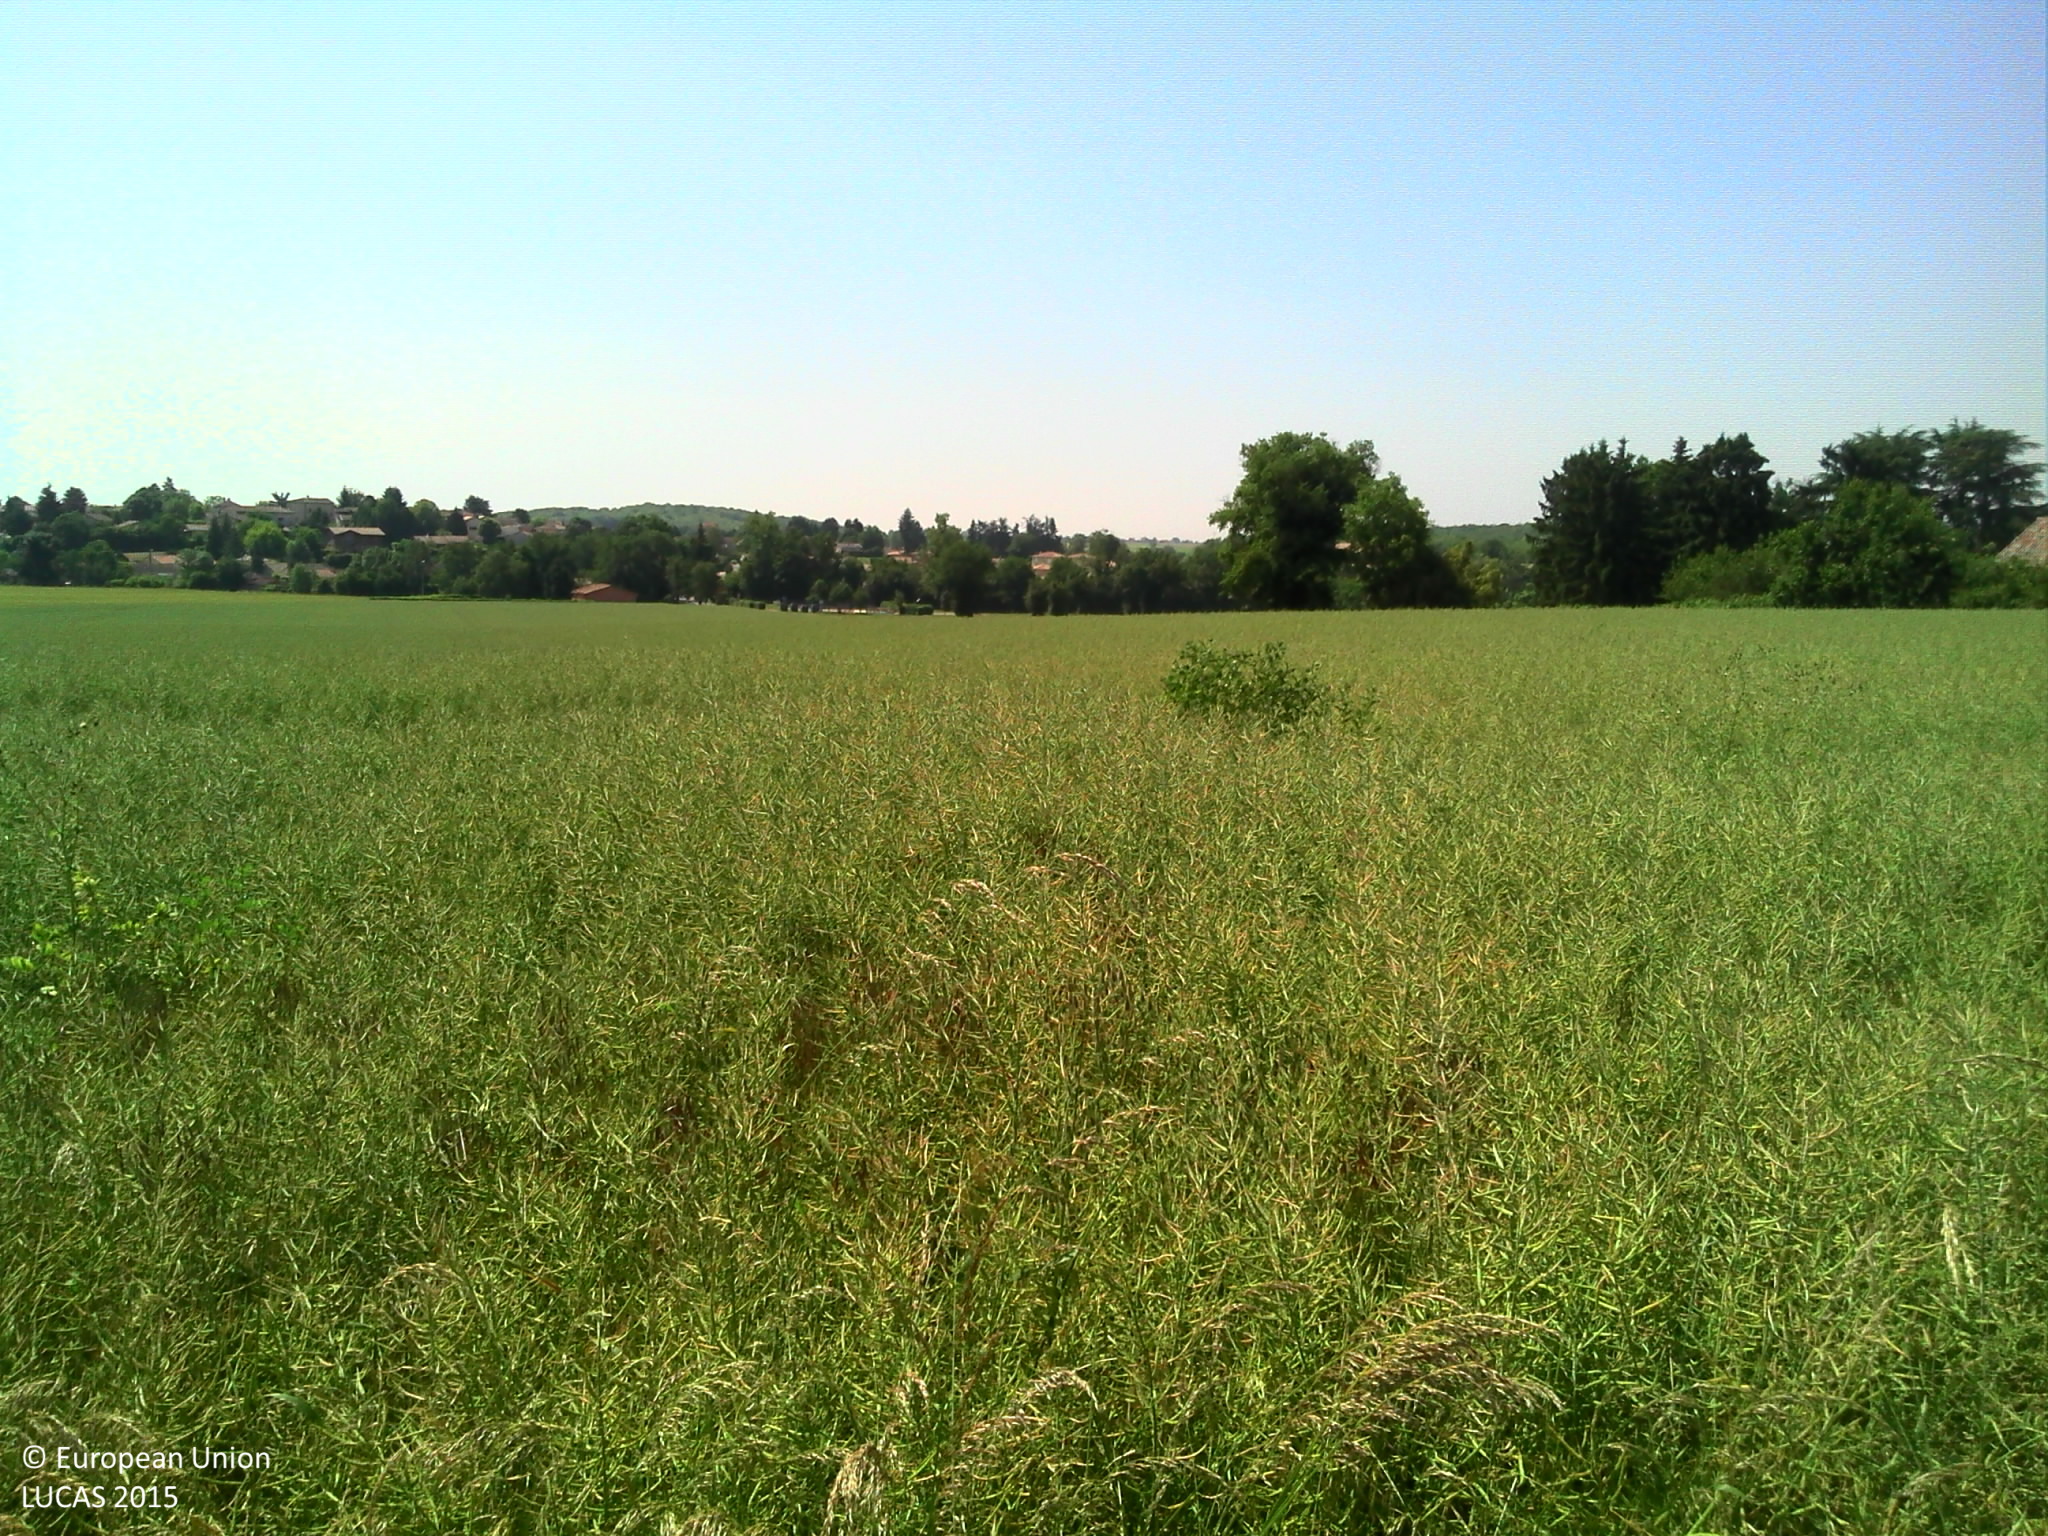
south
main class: Cropland
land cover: Rape and turnip rape
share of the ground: > 75 %
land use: Agriculture (excluding fallow land and kitchen gardens)
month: June
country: FR
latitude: 45.9579
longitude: 4.8808
